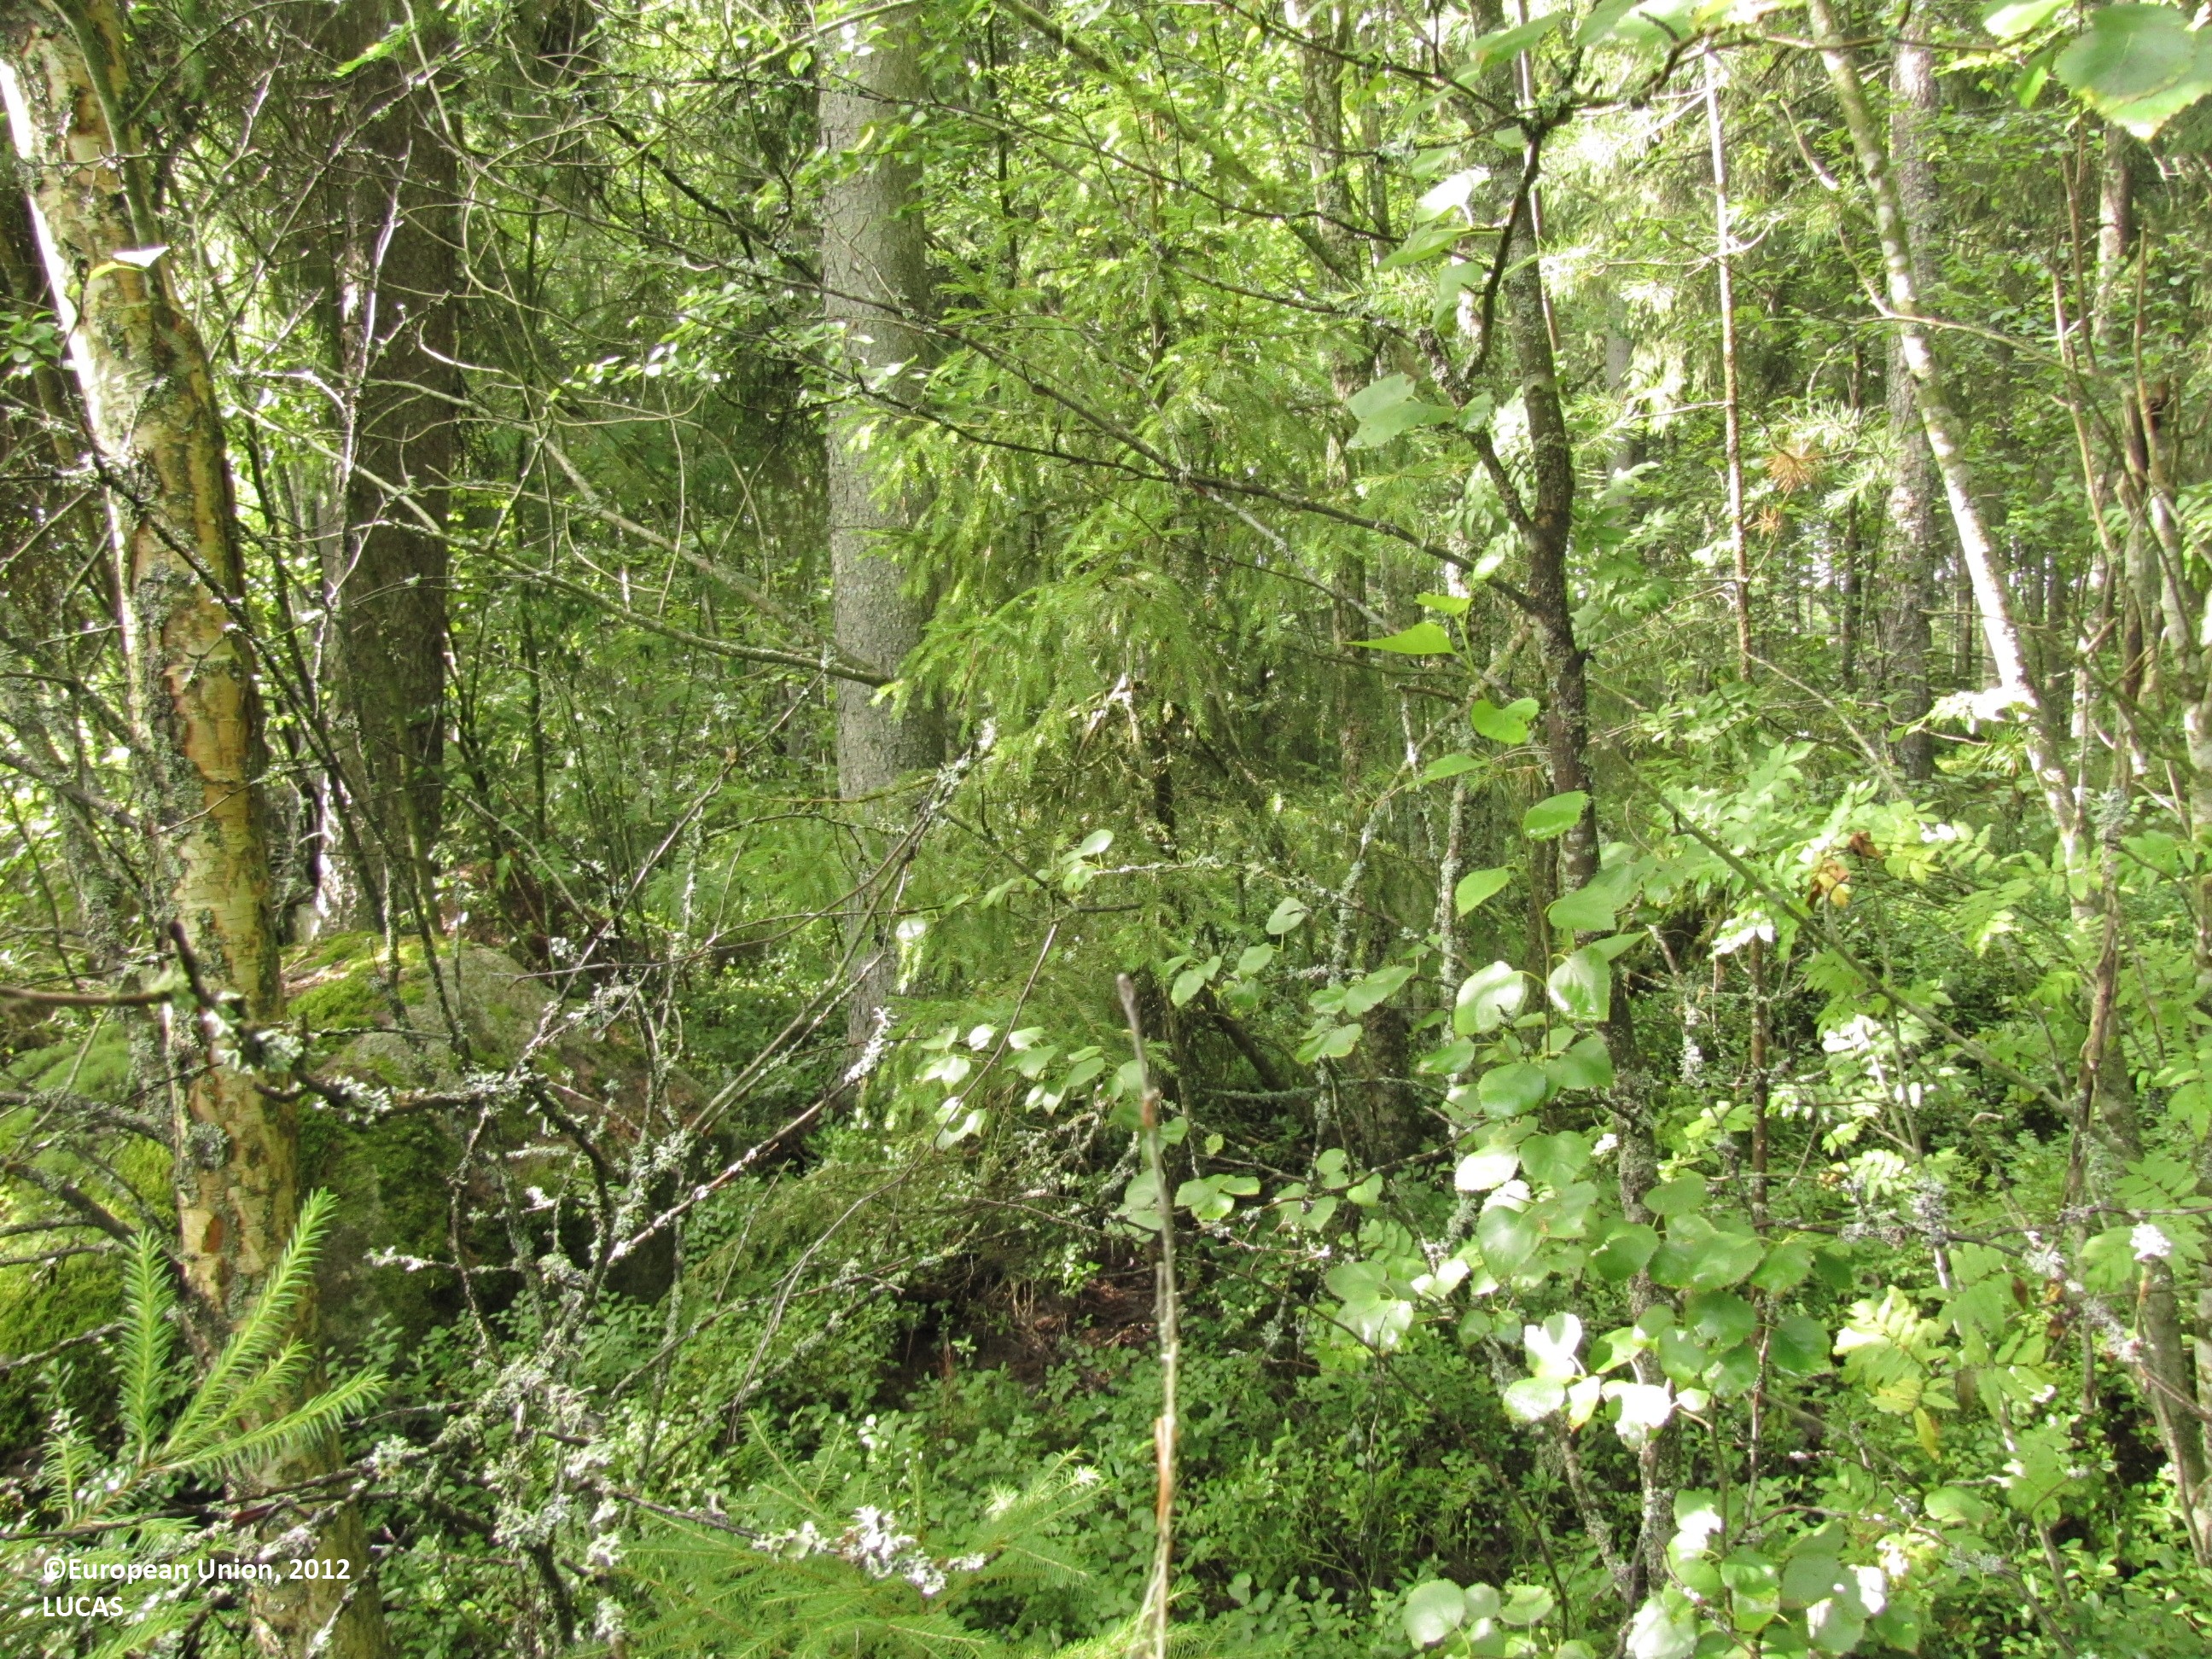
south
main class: Woodland
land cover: Pine dominated mixed woodland
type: boreal forest
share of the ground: 25 - 50 %
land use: Forestry
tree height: > 5 m
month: July
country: FI
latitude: 62.2036
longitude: 23.0801
